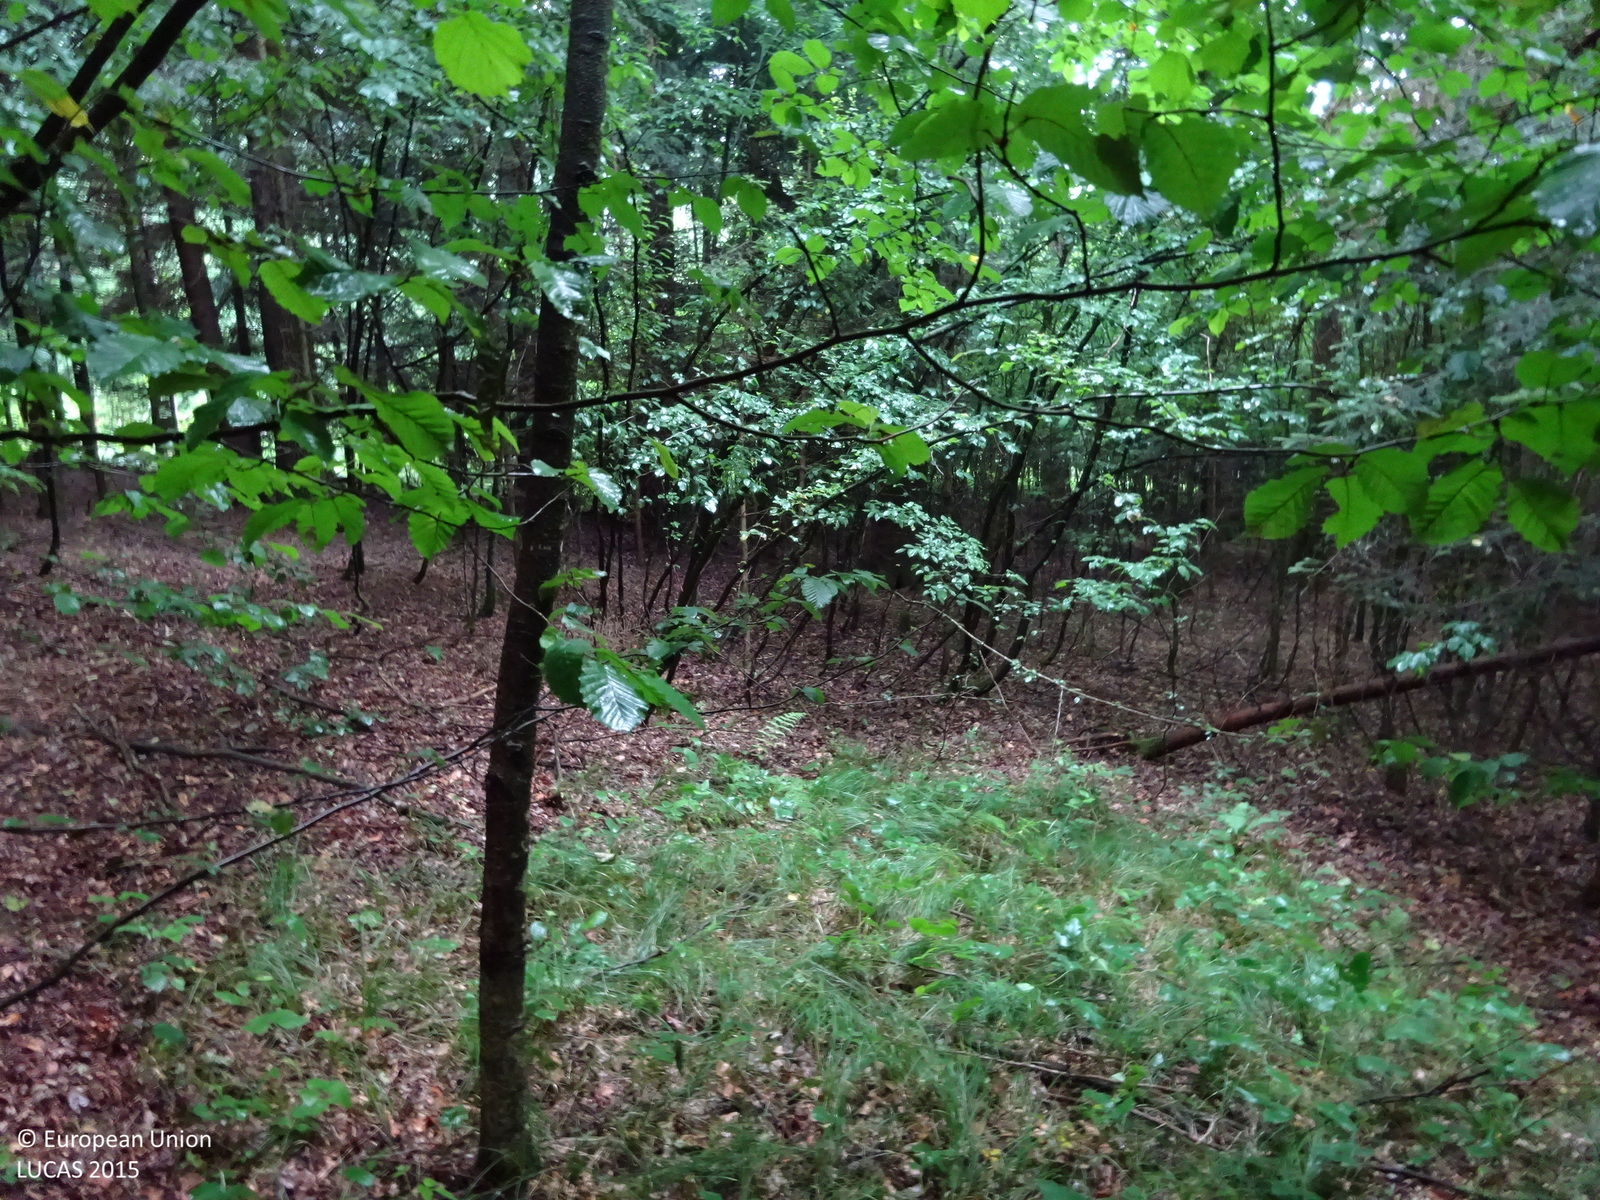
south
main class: Woodland
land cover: Spruce dominated mixed woodland
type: mountainous beech forest
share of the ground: > 75 %
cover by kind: coniferous forest trees 40 %, broadleaved forest trees 40 %, shrubs 20 %
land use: Forestry
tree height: > 5 m
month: July
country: AT
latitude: 46.8343
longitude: 15.2827
